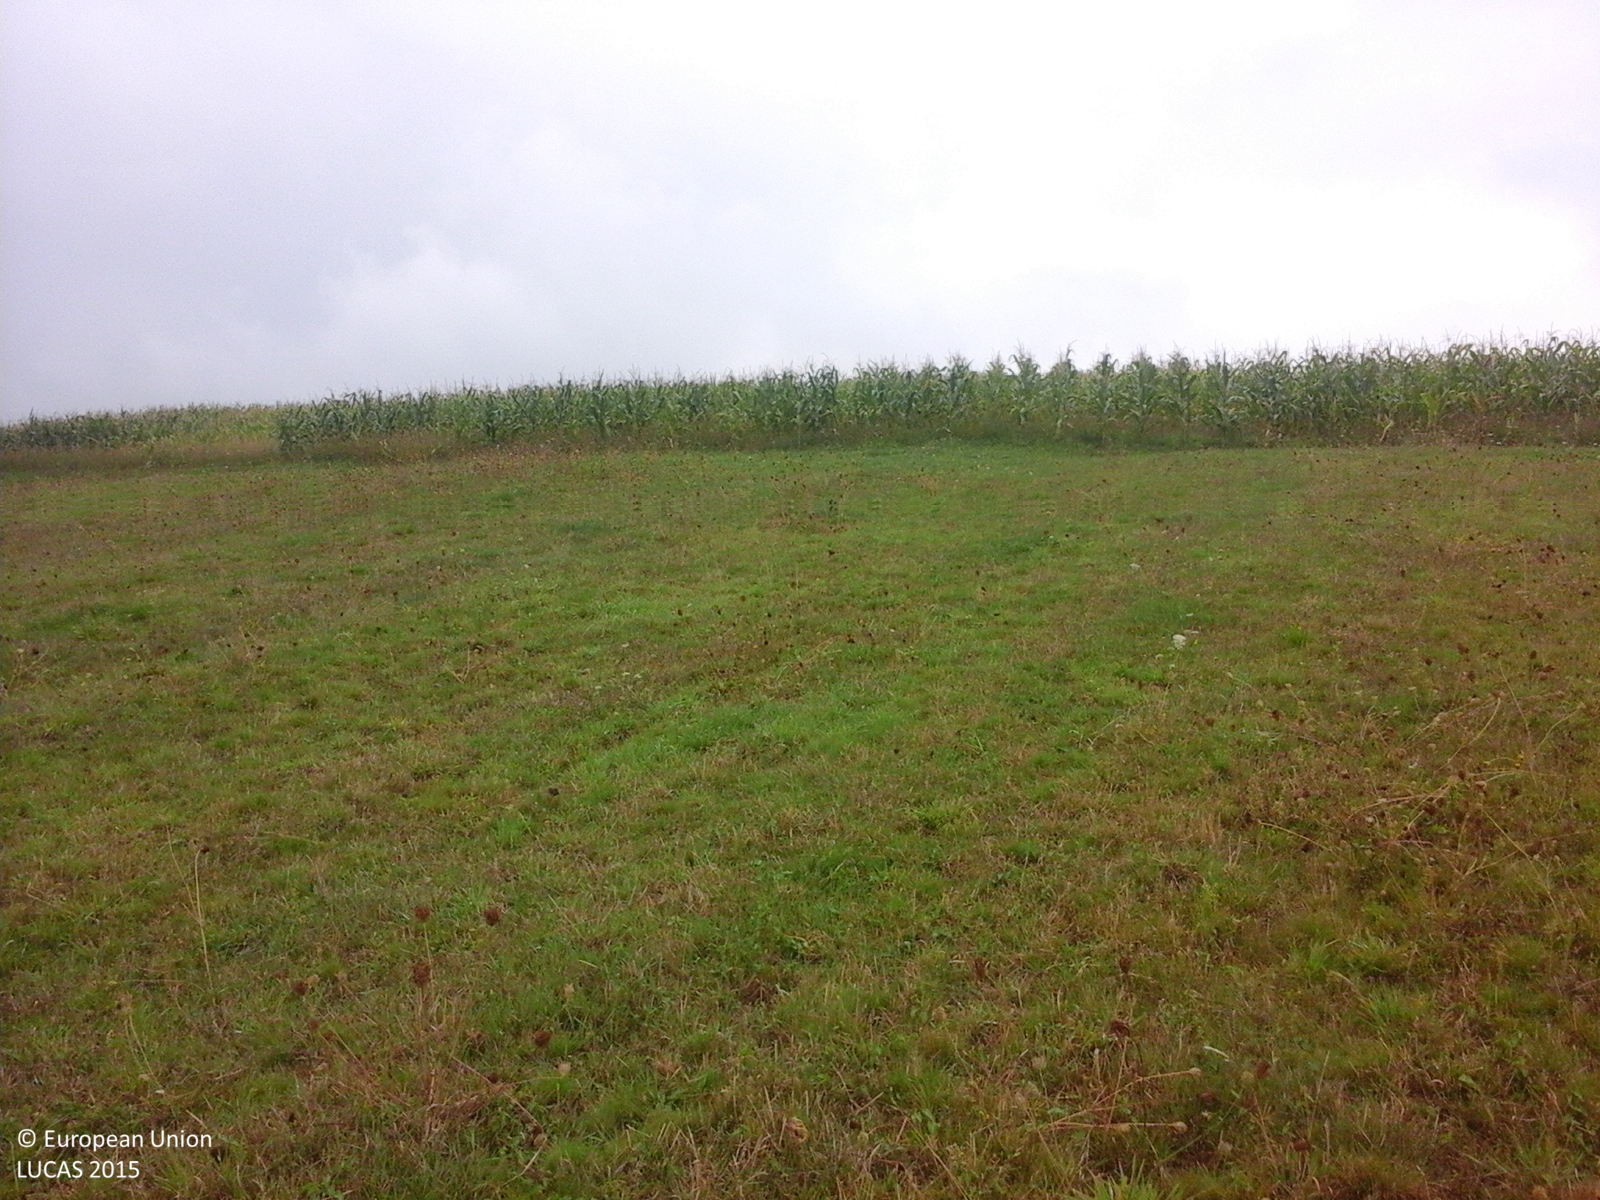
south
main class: Grassland
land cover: Grassland without tree/shrub cover
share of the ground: > 75 %
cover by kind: herbaceous plants 100 %
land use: Agriculture (excluding fallow land and kitchen gardens)
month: September
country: RO
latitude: 46.9712
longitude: 22.5817
